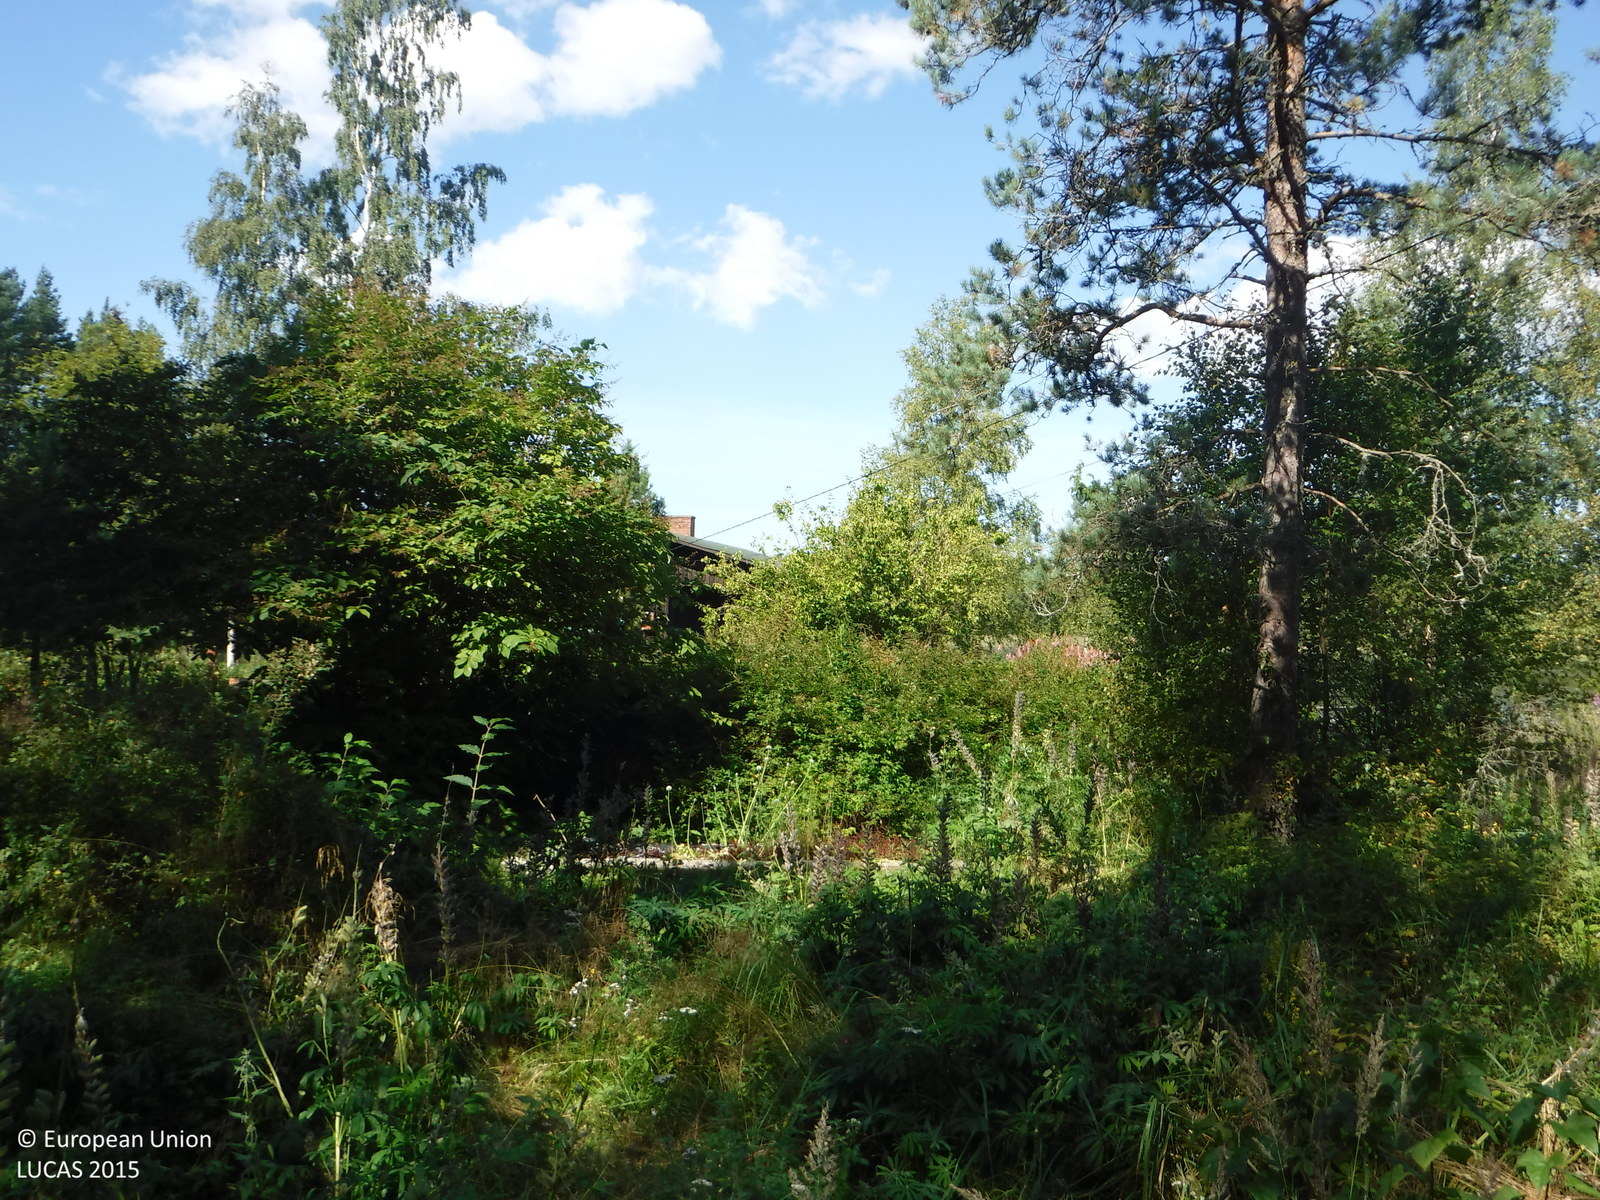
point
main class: Shrubland
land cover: Shrubland with sparse tree cover
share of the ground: 50 - 75 %
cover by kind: shrubs 60 %, herbaceous plants 25 %, consolidated bare surface 10 %, coniferous forest trees 5 %
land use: Amenities, museums, leisure
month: August
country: FI
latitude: 61.1622
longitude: 21.5578
